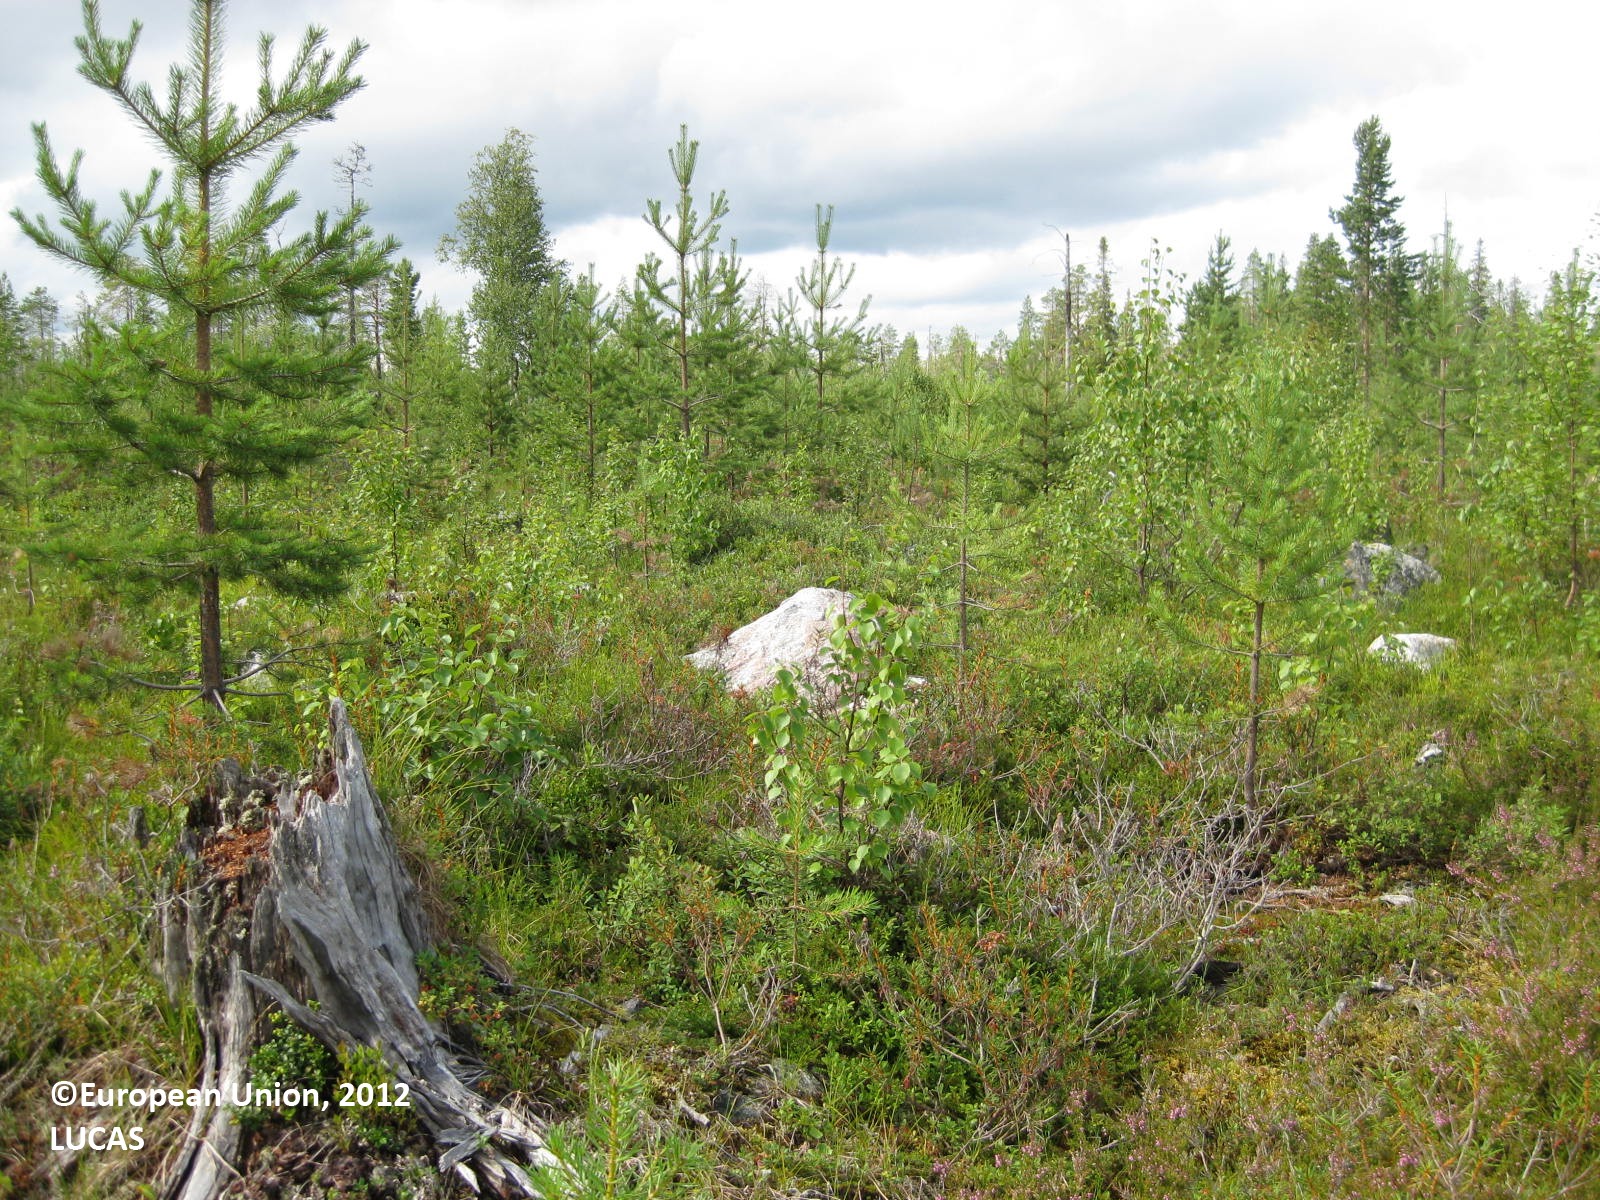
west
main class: Woodland
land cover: Pine dominated mixed woodland
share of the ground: 50 - 75 %
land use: Forestry
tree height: < 5 m
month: July
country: FI
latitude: 65.9332
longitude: 28.6415
